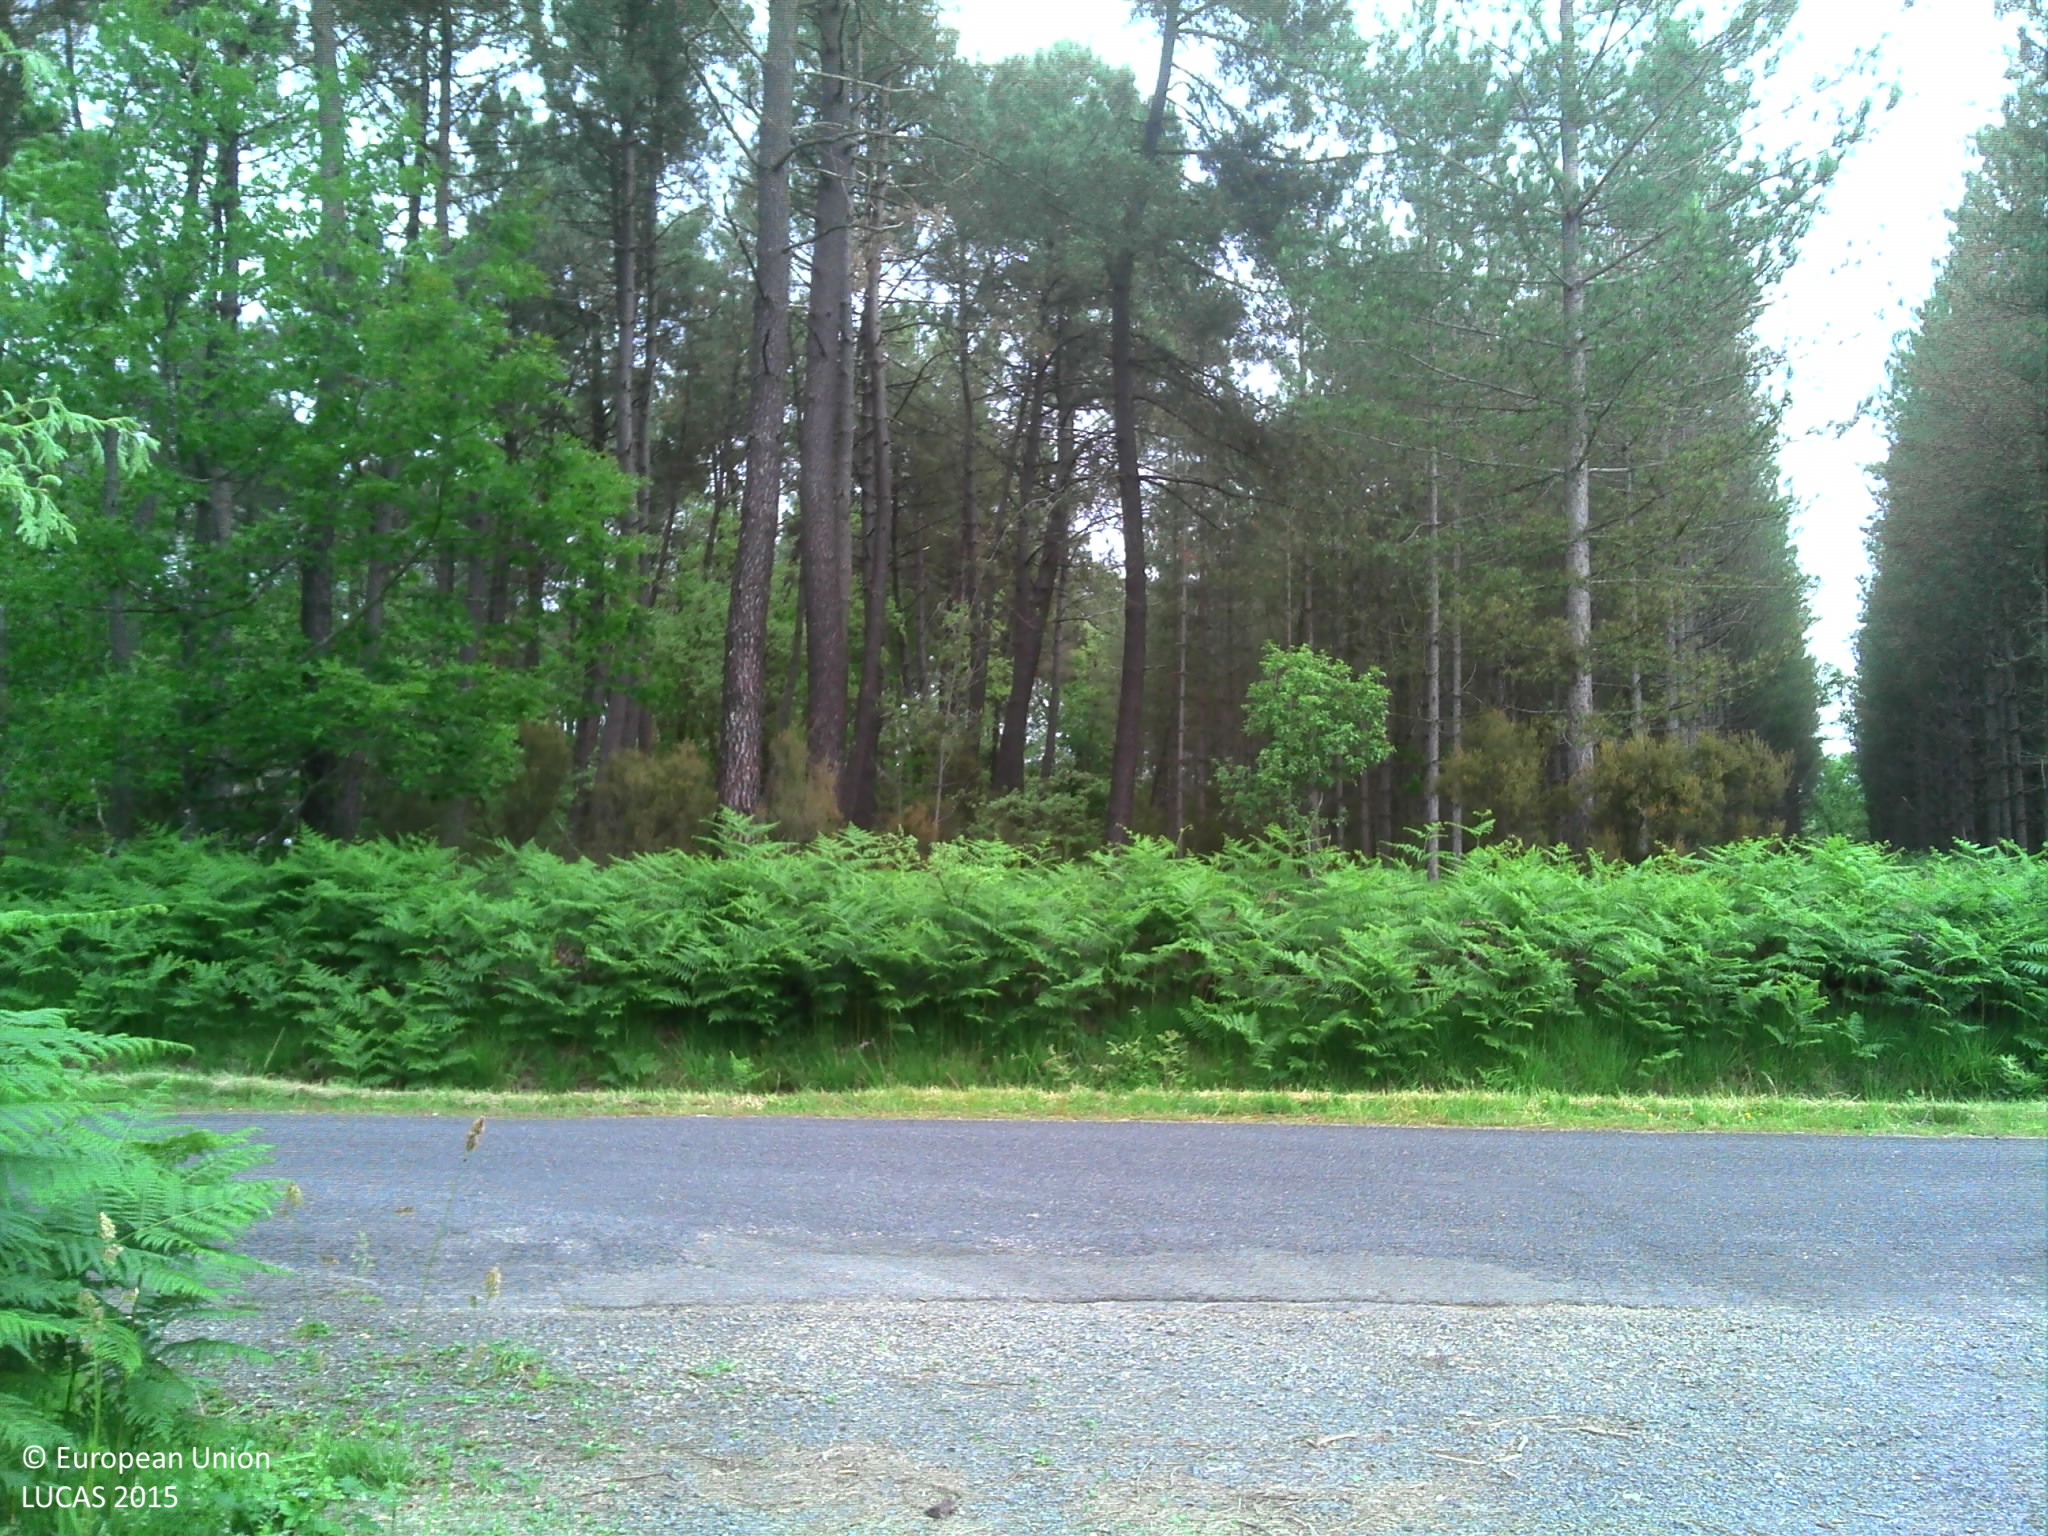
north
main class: Woodland
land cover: Pine dominated mixed woodland
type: hemiboreal forest and nemoral coniferous forest and mixed broadleaved-coniferous forest
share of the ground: > 75 %
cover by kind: coniferous forest trees 55 %, broadleaved forest trees 20 %, herbaceous plants 15 %, lichens and mosses 5 %, consolidated bare surface 5 %
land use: Forestry
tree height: > 5 m
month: June
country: FR
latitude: 47.6209
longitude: -0.0192
